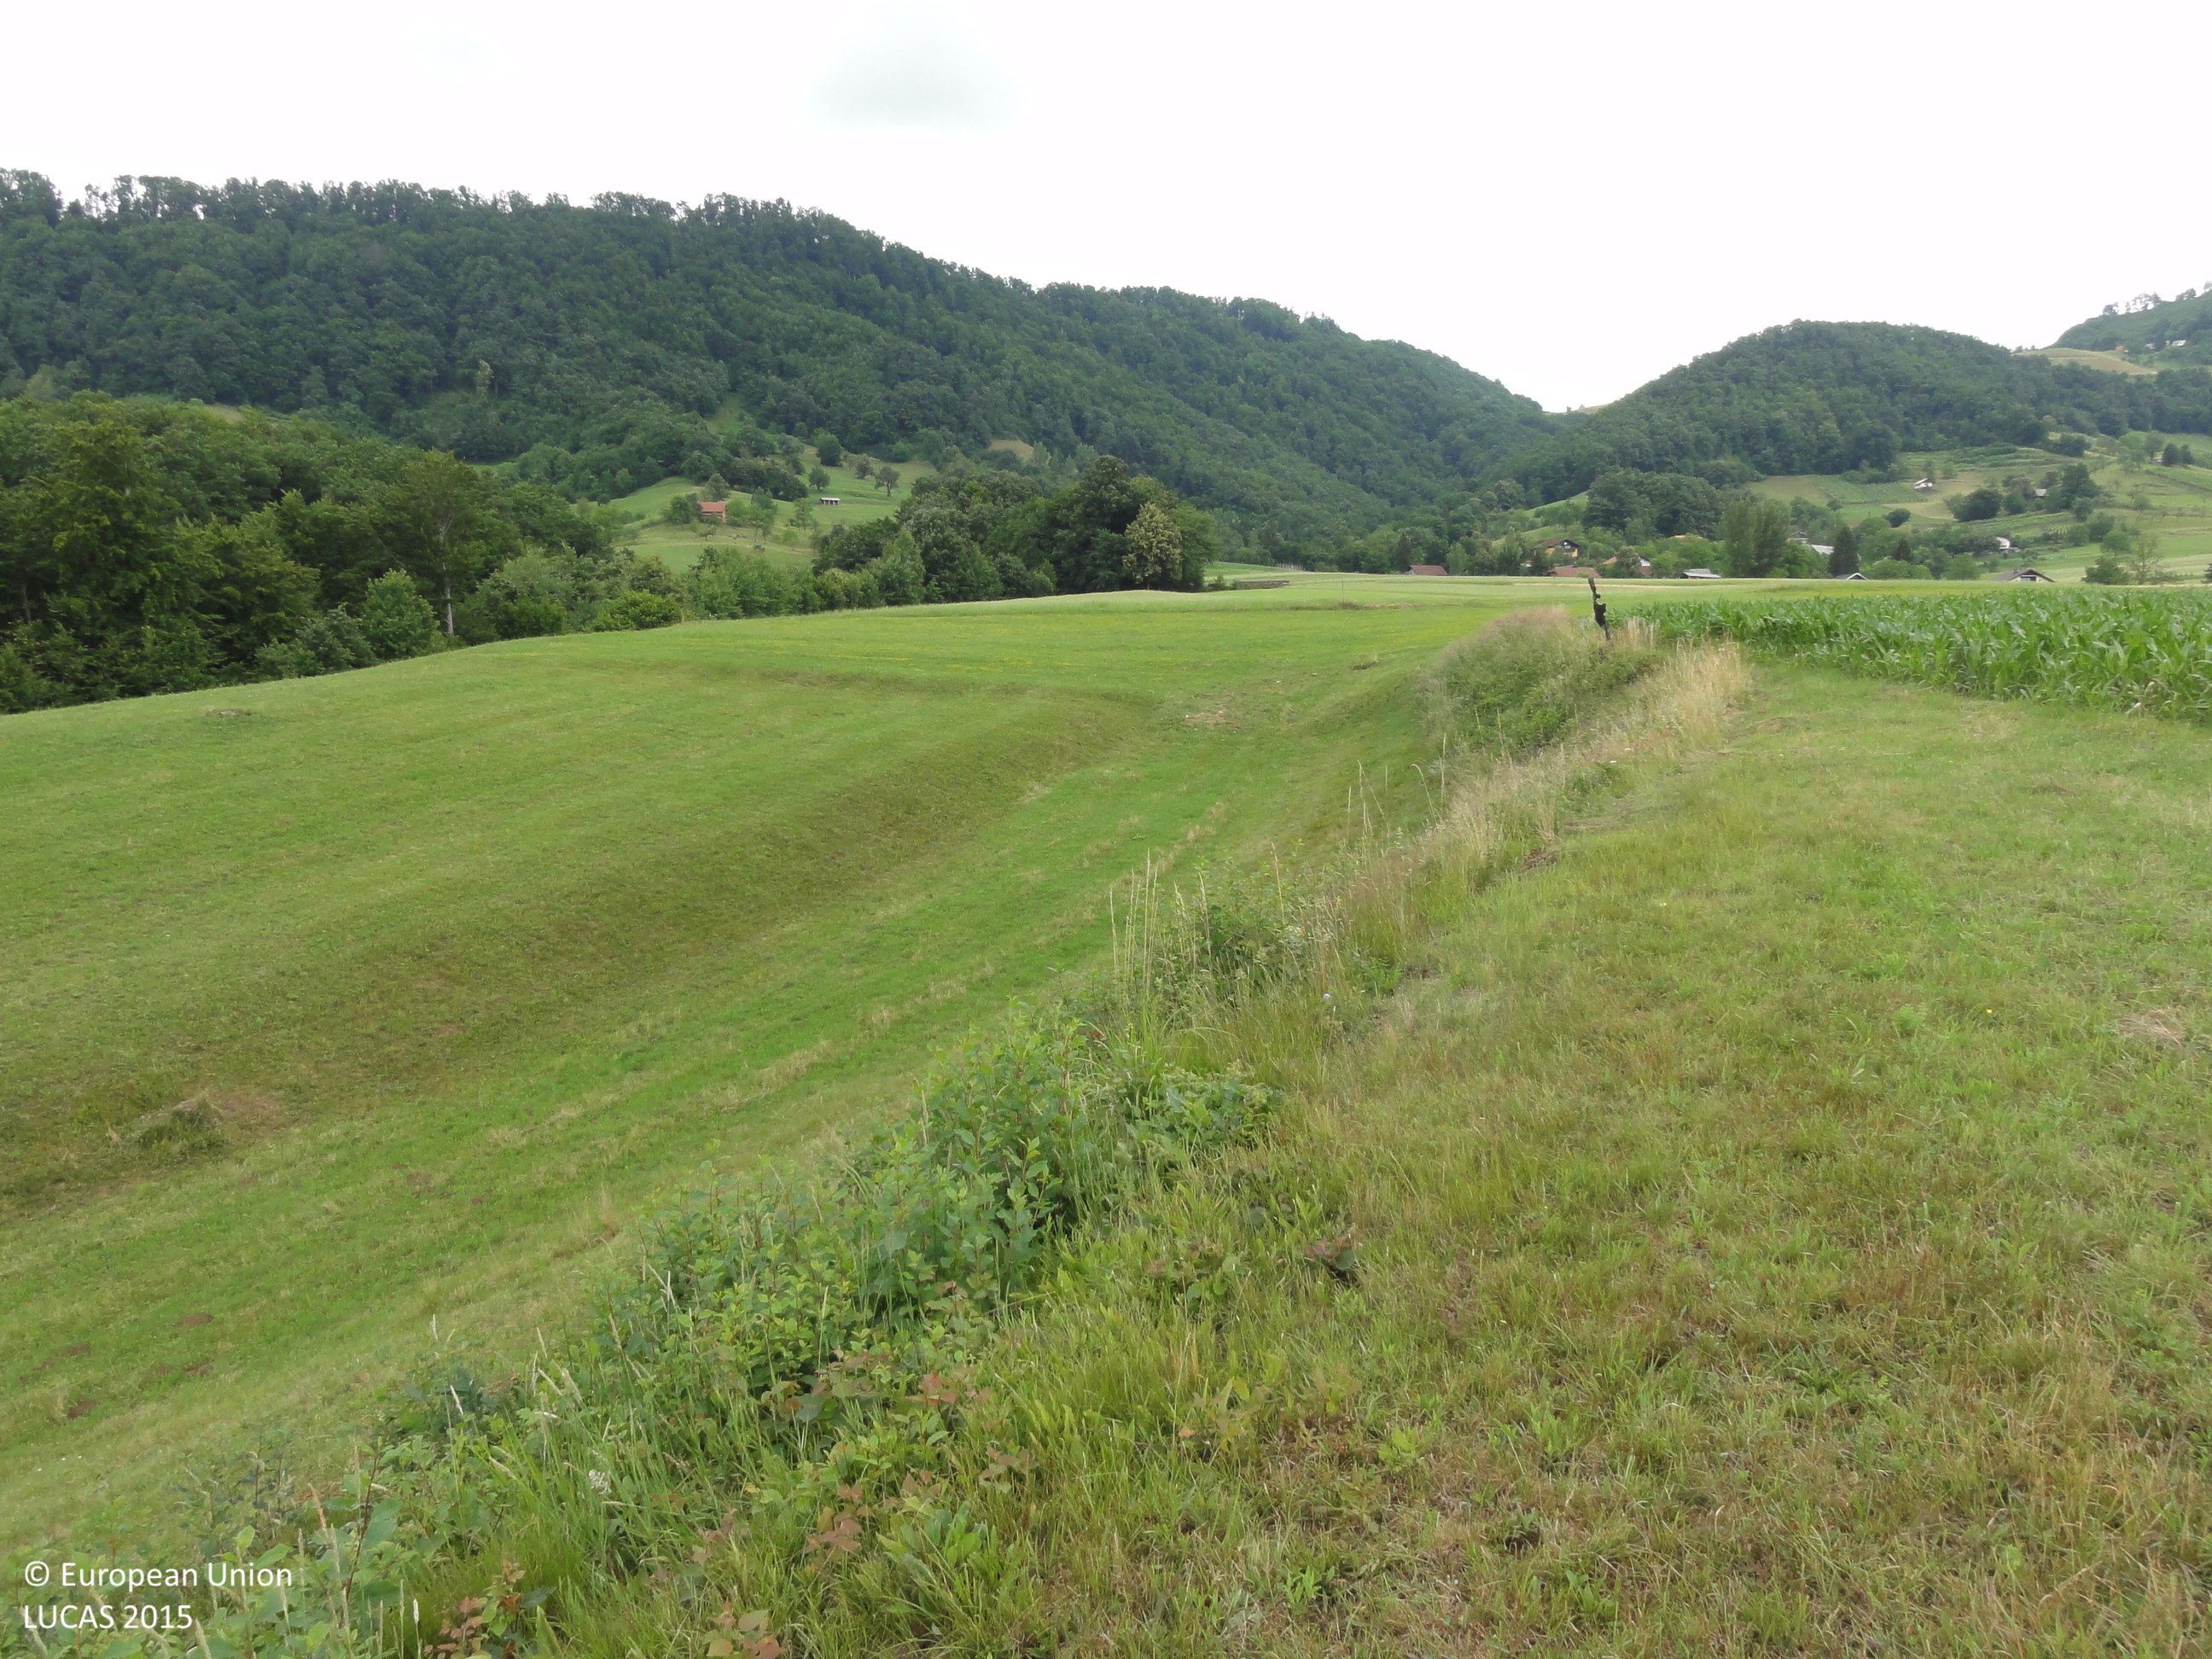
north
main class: Grassland
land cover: Grassland without tree/shrub cover
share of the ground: > 75 %
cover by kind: herbaceous plants 100 %
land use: Agriculture (excluding fallow land and kitchen gardens)
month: June
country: SI
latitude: 46.2524
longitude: 15.7189
